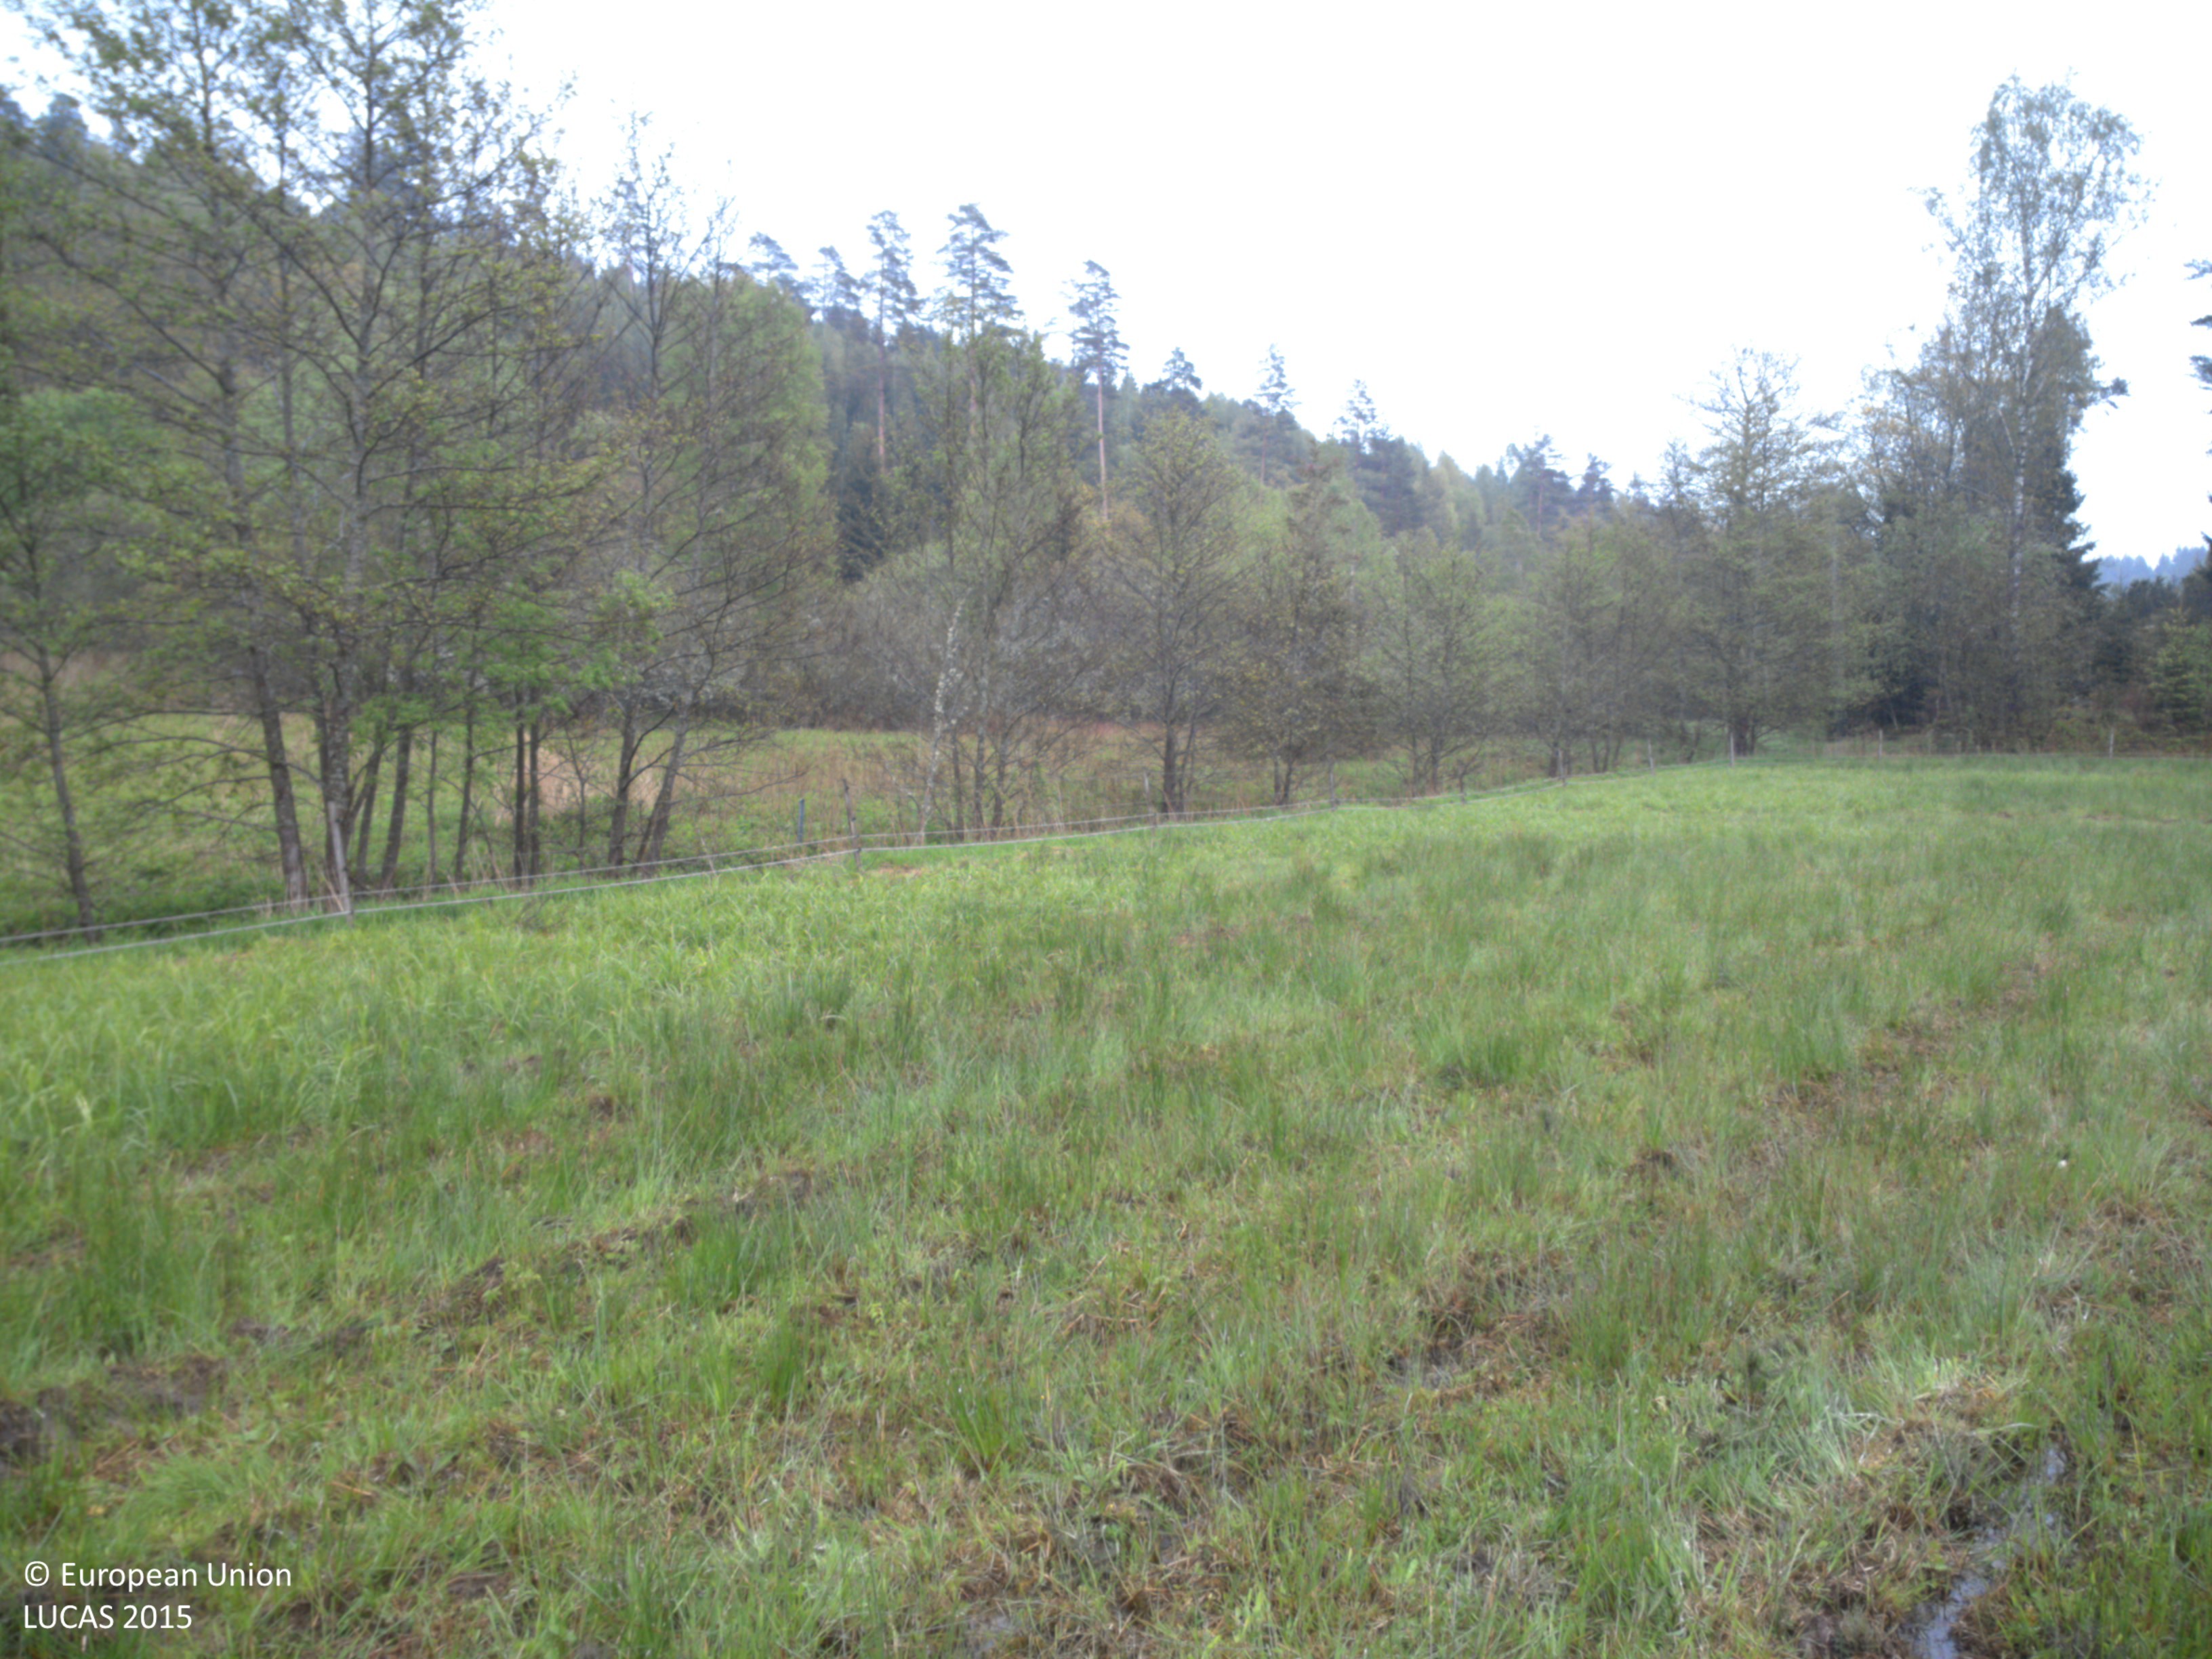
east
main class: Grassland
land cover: Grassland without tree/shrub cover
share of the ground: > 75 %
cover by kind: herbaceous plants 100 %
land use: Agriculture (excluding fallow land and kitchen gardens)
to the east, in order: Grassland without tree/shrub cover; Fences; Abandoned hedges; Ditches and canals; Abandoned hedges; Grassland without tree/shrub cover; Broadleaved woodland; Grass margins; Paved roads, cycling and walking lanes; Ditches and canals; Spruce dominated coniferous woodland; Pine dominated mixed woodland
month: May
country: SE
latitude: 58.3708
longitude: 11.6891
